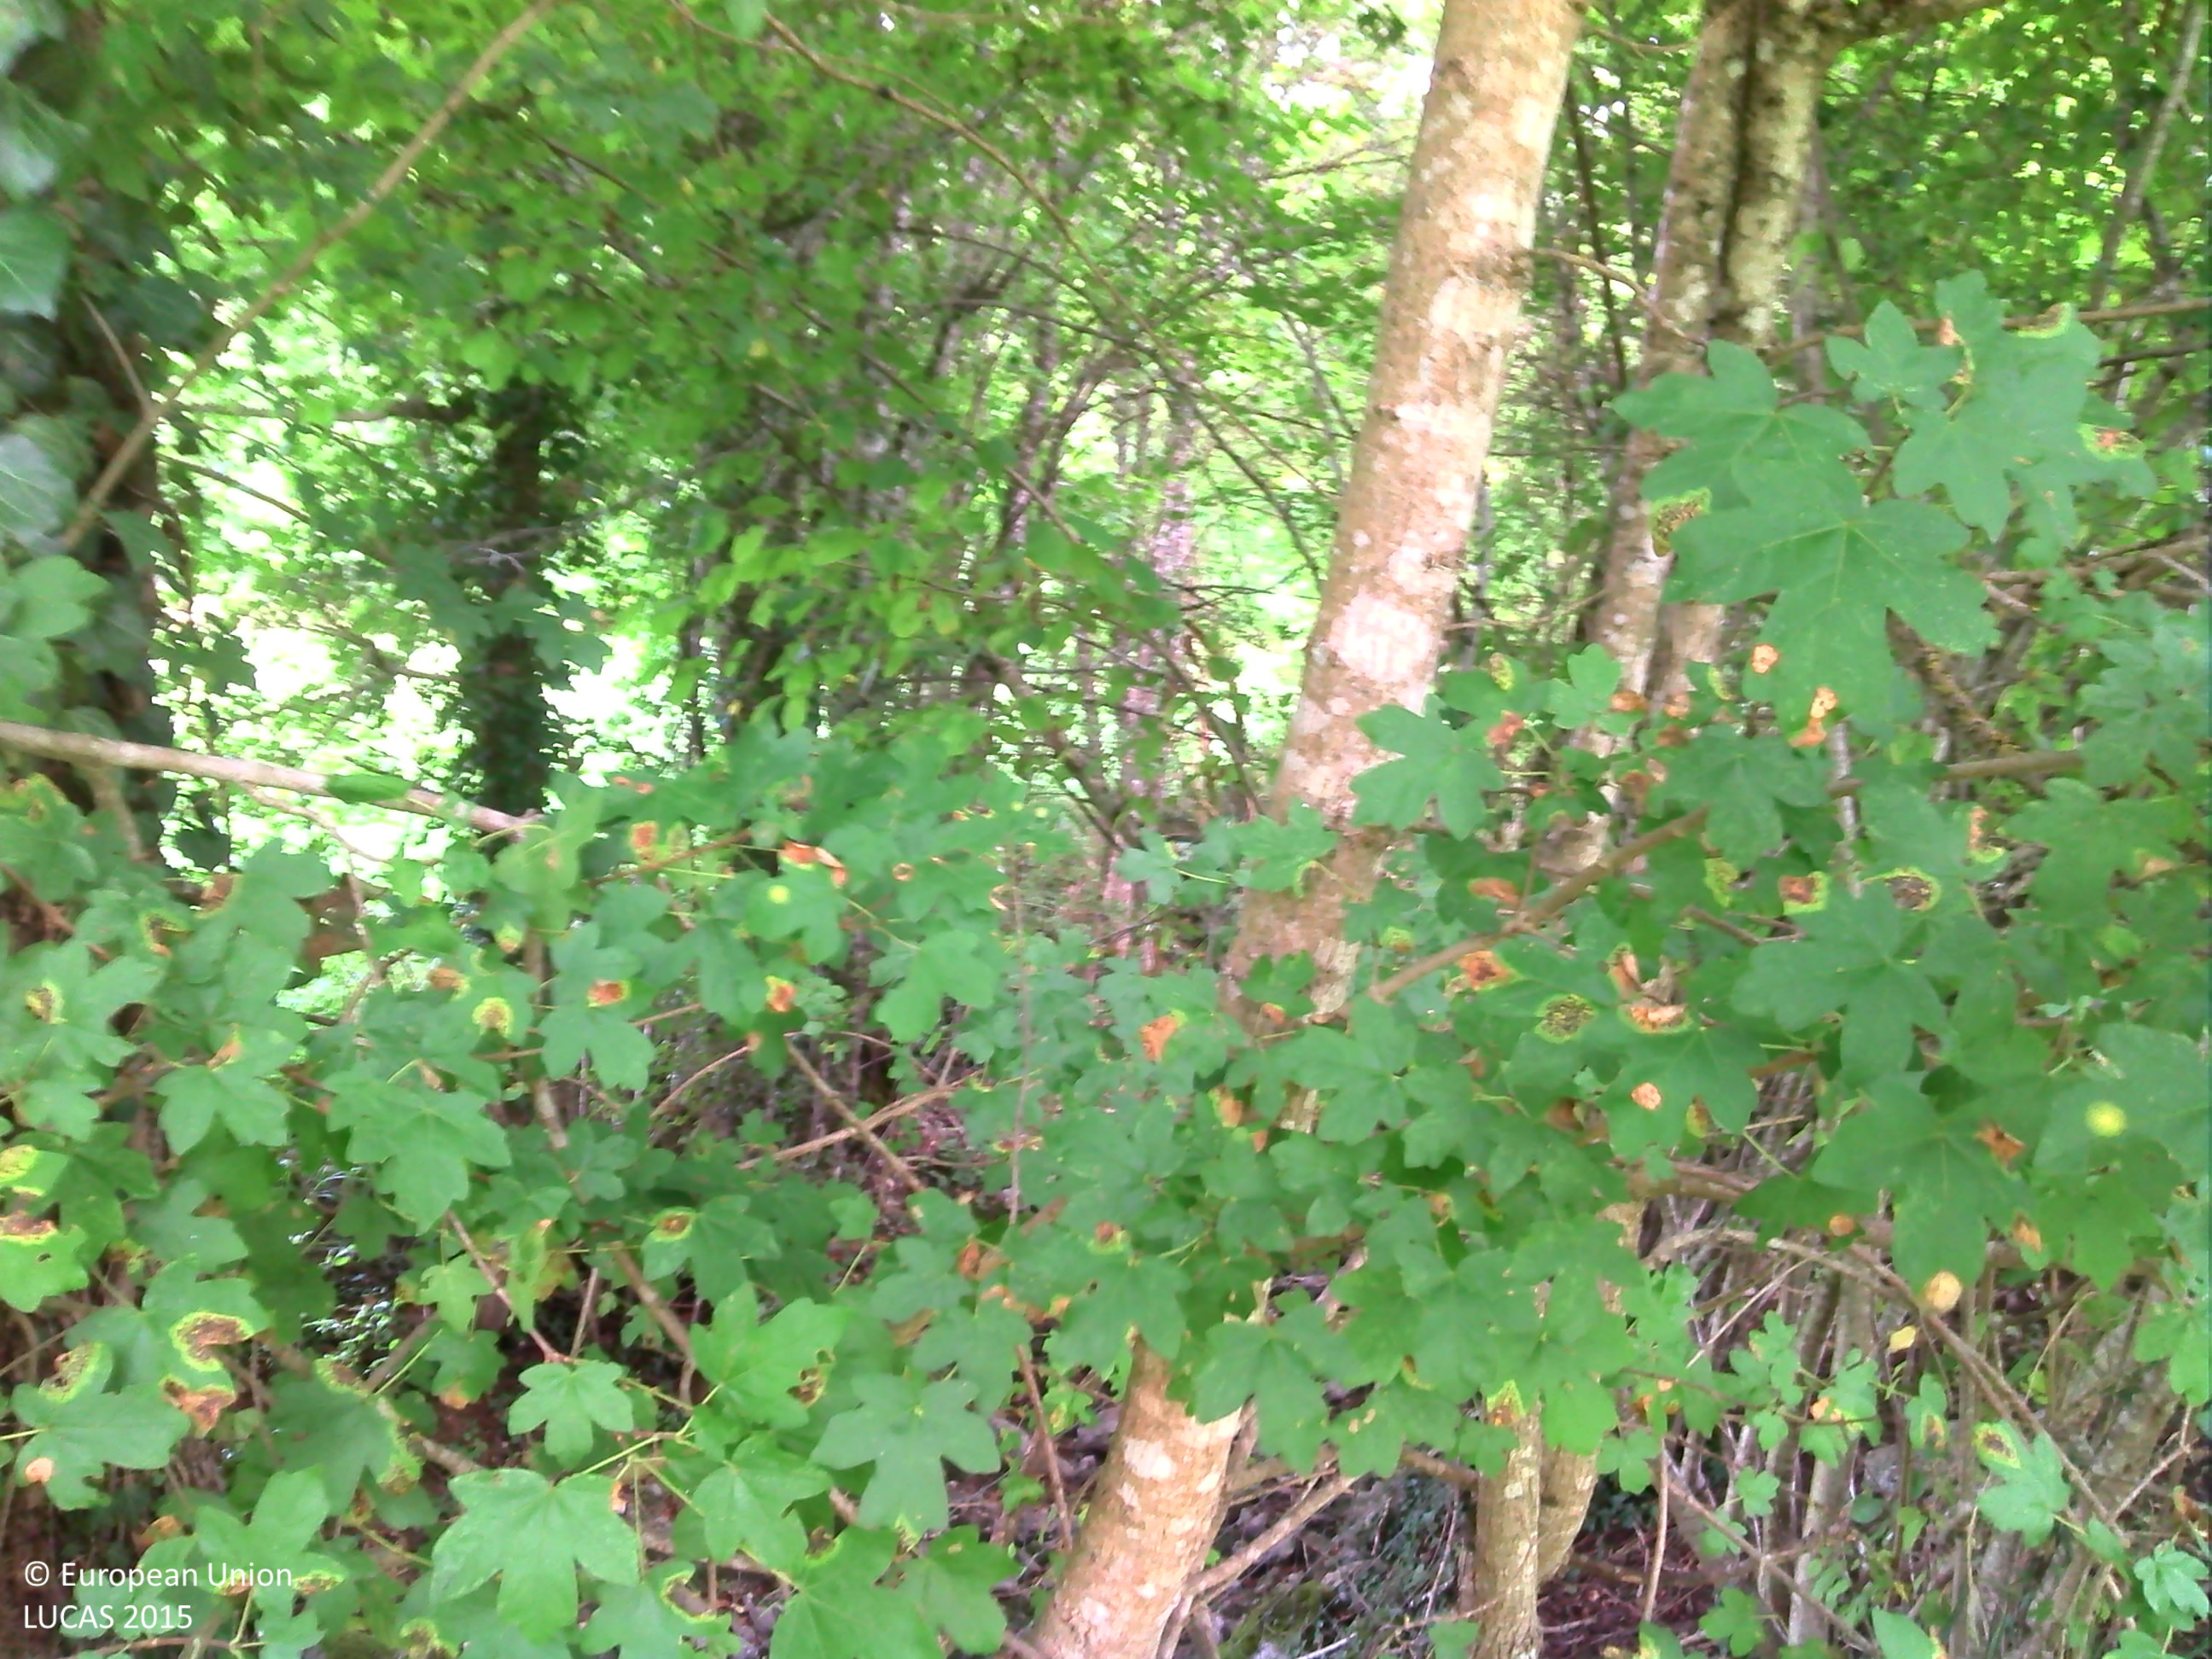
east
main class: Woodland
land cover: Broadleaved woodland
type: non-riverine alder, birch or aspen forest
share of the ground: > 75 %
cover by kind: broadleaved forest trees 60 %, shrubs 20 %, herbaceous plants 20 %
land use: Semi-natural and natural areas not in use
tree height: > 5 m
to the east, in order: Broadleaved woodland; Fences; Rivers and streams; Broadleaved woodland; Grassland without tree/shrub cover; Broadleaved woodland; Grass margins; Tracks; Grass margins; Abandoned hedges; Grass margins; Paved roads, cycling and walking lanes; Grass margins; Ditches and canals; Grass margins; Broadleaved woodland; Fences; Broadleaved woodland; Dry stone walls; Abandoned hedges; Grassland without tree/shrub cover; Shrubland with sparse tree cover; Fences; Grass margins; Tracks; Grassland without tree/shrub cover
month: September
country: FR
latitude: 44.6527
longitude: 1.4857
